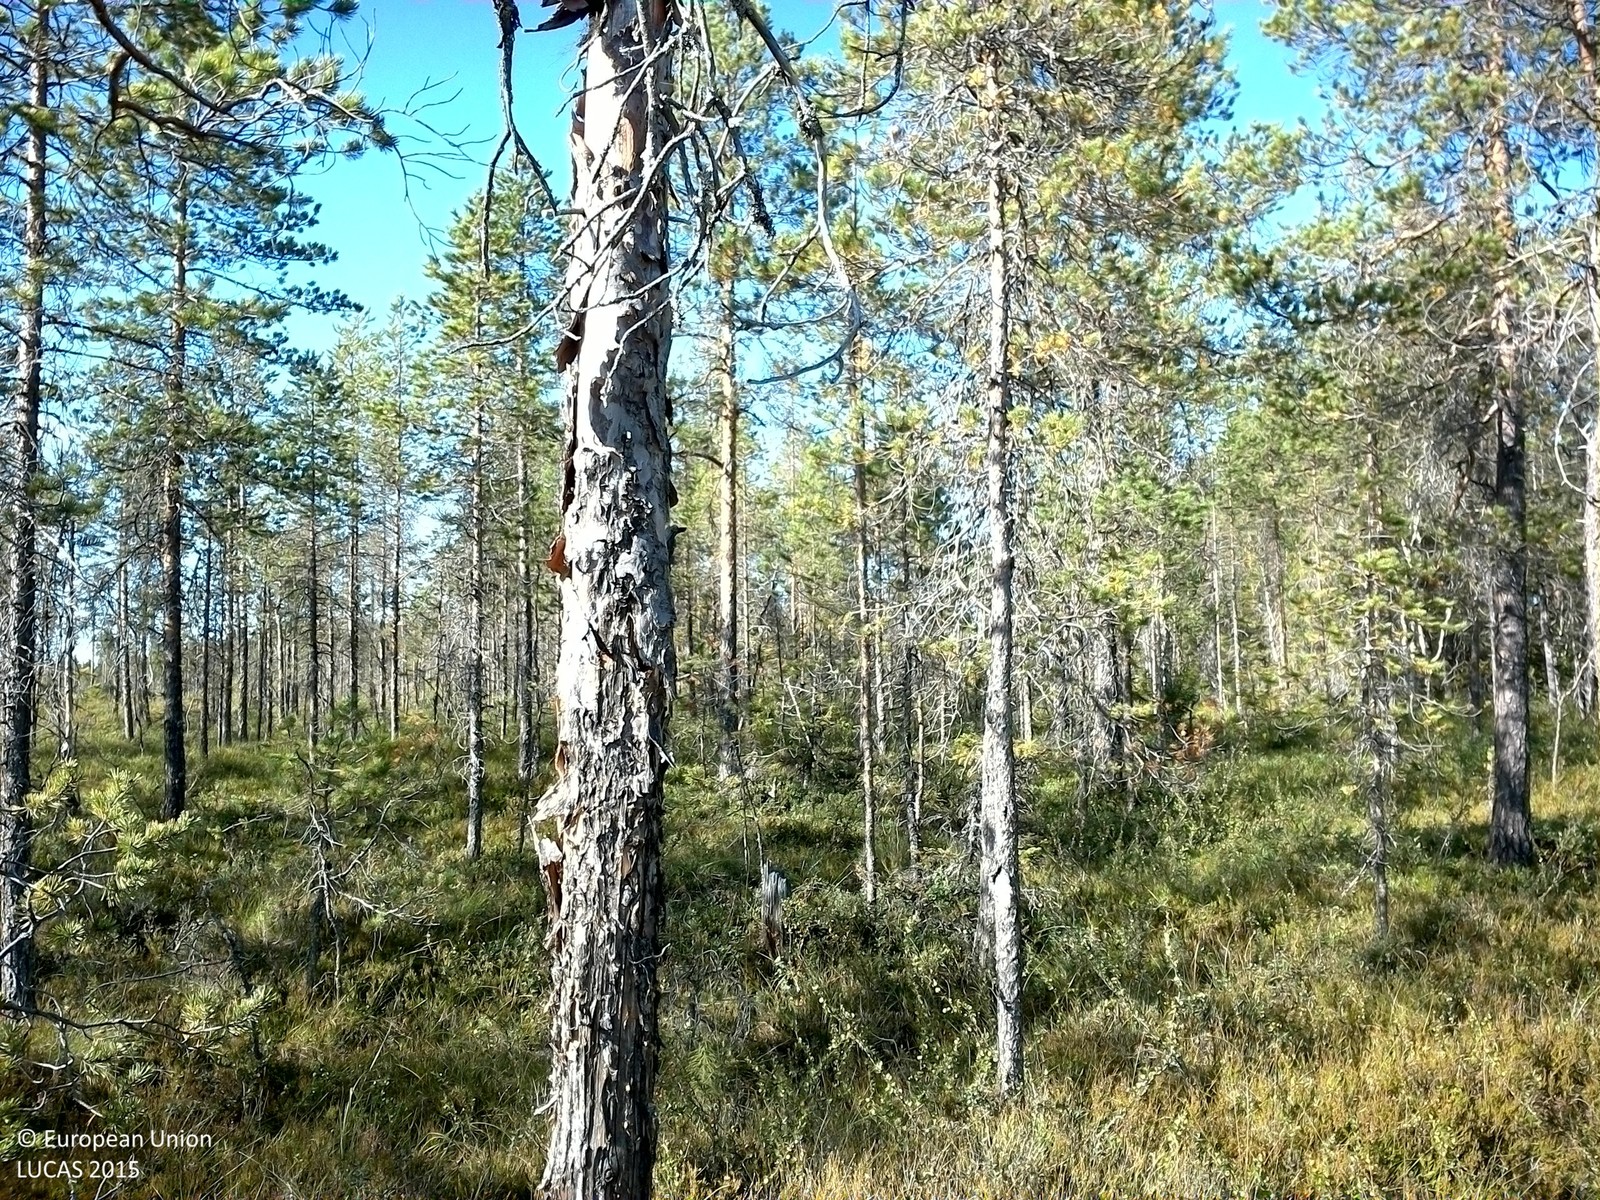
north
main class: Woodland
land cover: Pine dominated coniferous woodland
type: boreal forest
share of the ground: 25 - 50 %
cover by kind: shrubs 40 %, coniferous forest trees 30 %, lichens and mosses 30 %
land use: Semi-natural and natural areas not in use
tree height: < 5 m
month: August
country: SE
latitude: 63.6499
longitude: 18.0310
